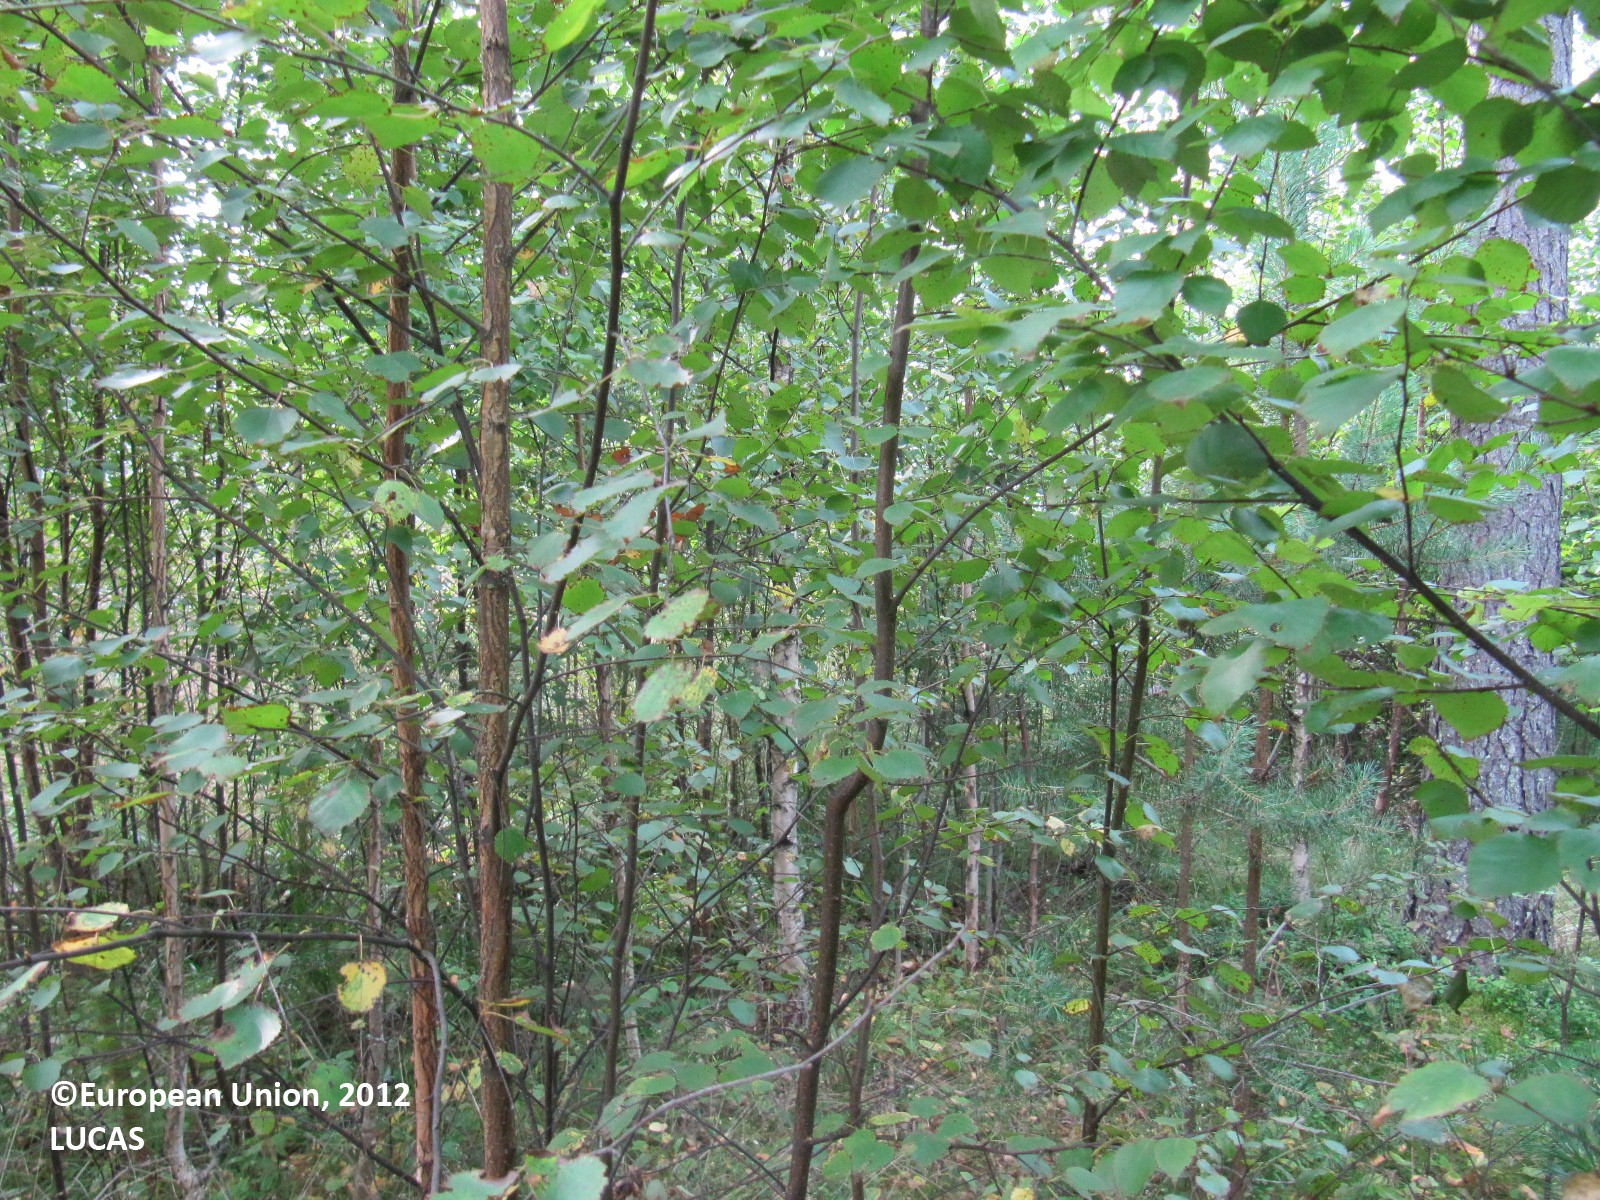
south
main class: Woodland
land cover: Other mixed woodland
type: boreal forest
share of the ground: 50 - 75 %
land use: Forestry
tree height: < 5 m
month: August
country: FI
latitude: 60.4684
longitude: 23.2320
